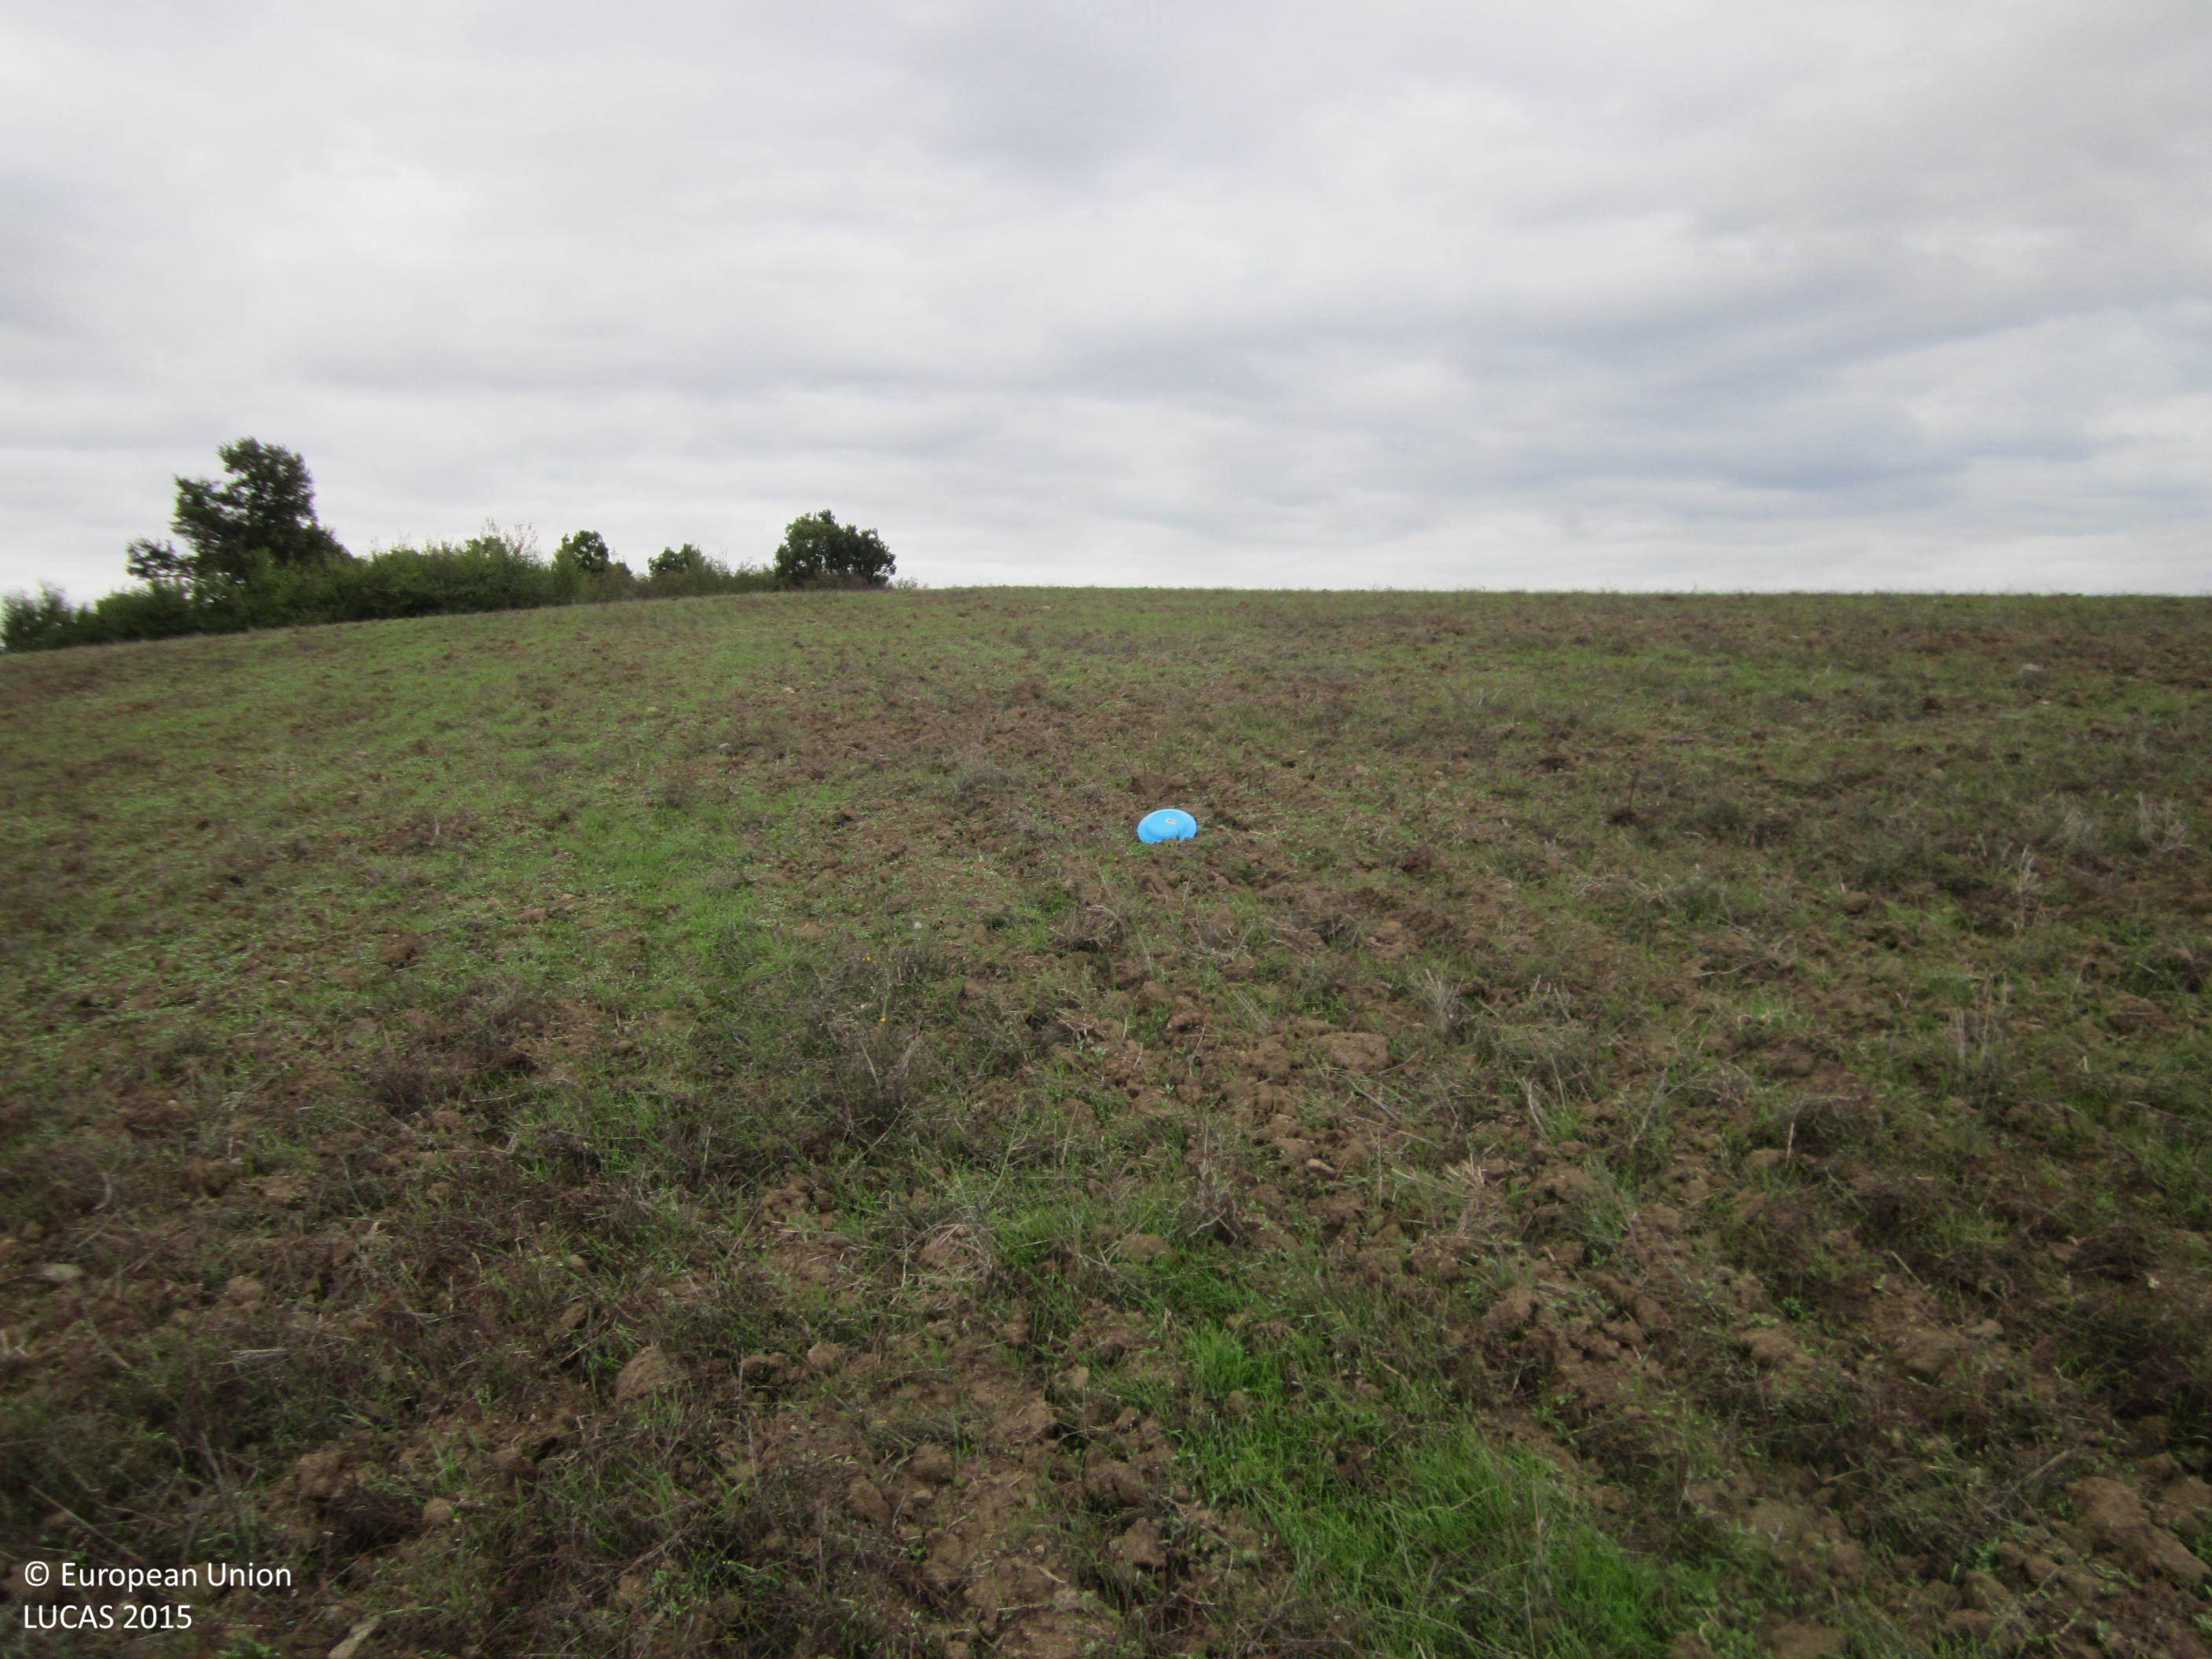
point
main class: Cropland
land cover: Common wheat
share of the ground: 10 - 25 %
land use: Agriculture (excluding fallow land and kitchen gardens)
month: October
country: BG
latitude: 42.3454
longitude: 27.1117
